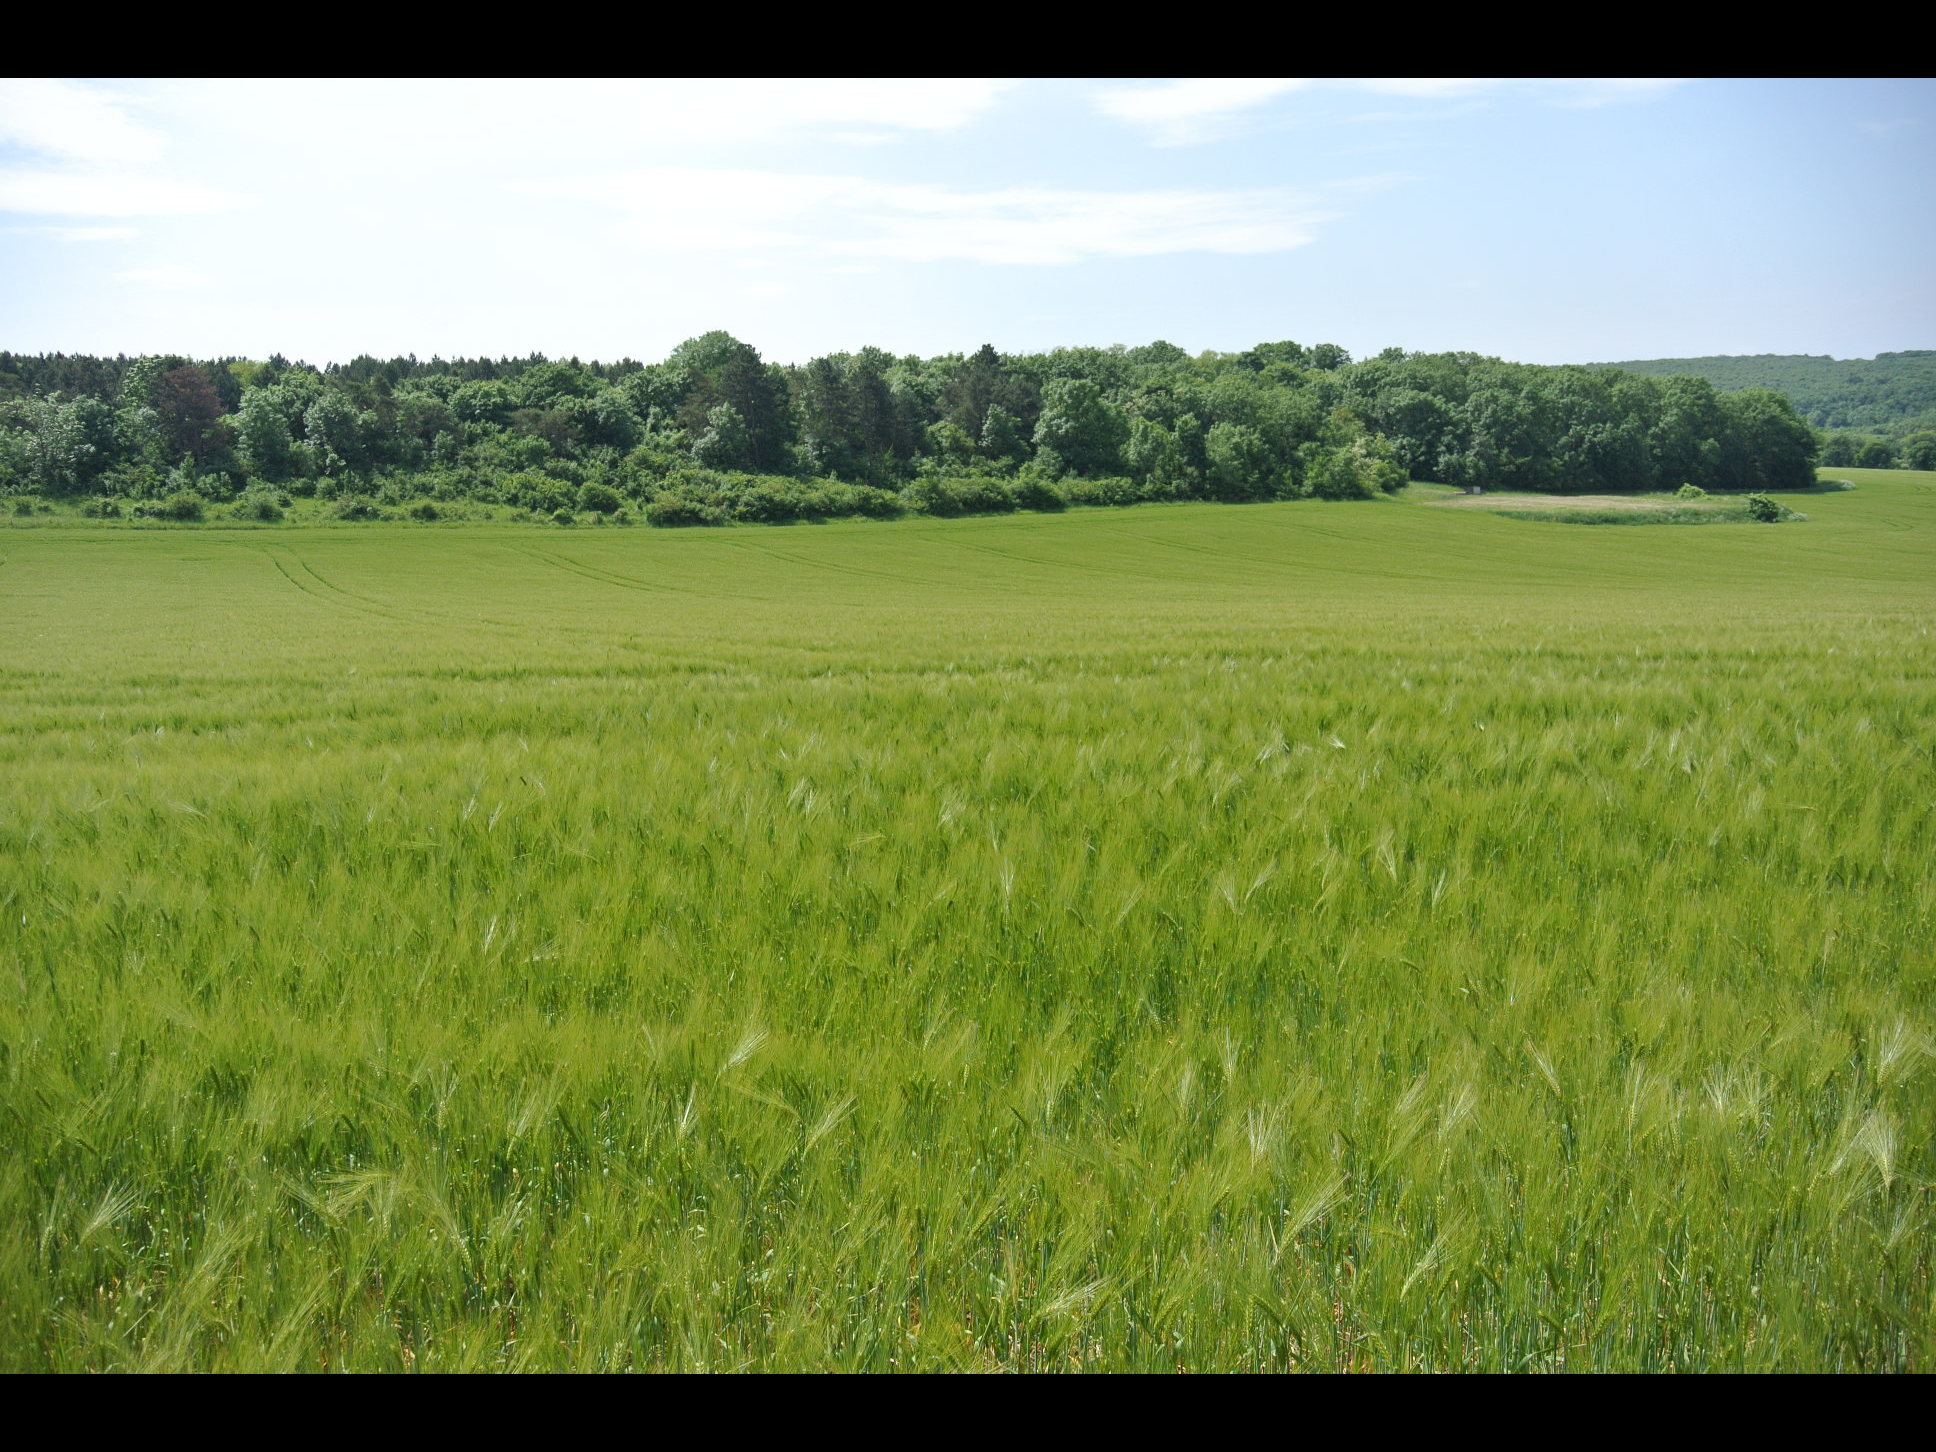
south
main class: Cropland
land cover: Barley
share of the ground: > 75 %
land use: Agriculture (excluding fallow land and kitchen gardens)
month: May
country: AT
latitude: 48.0133
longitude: 16.8031
